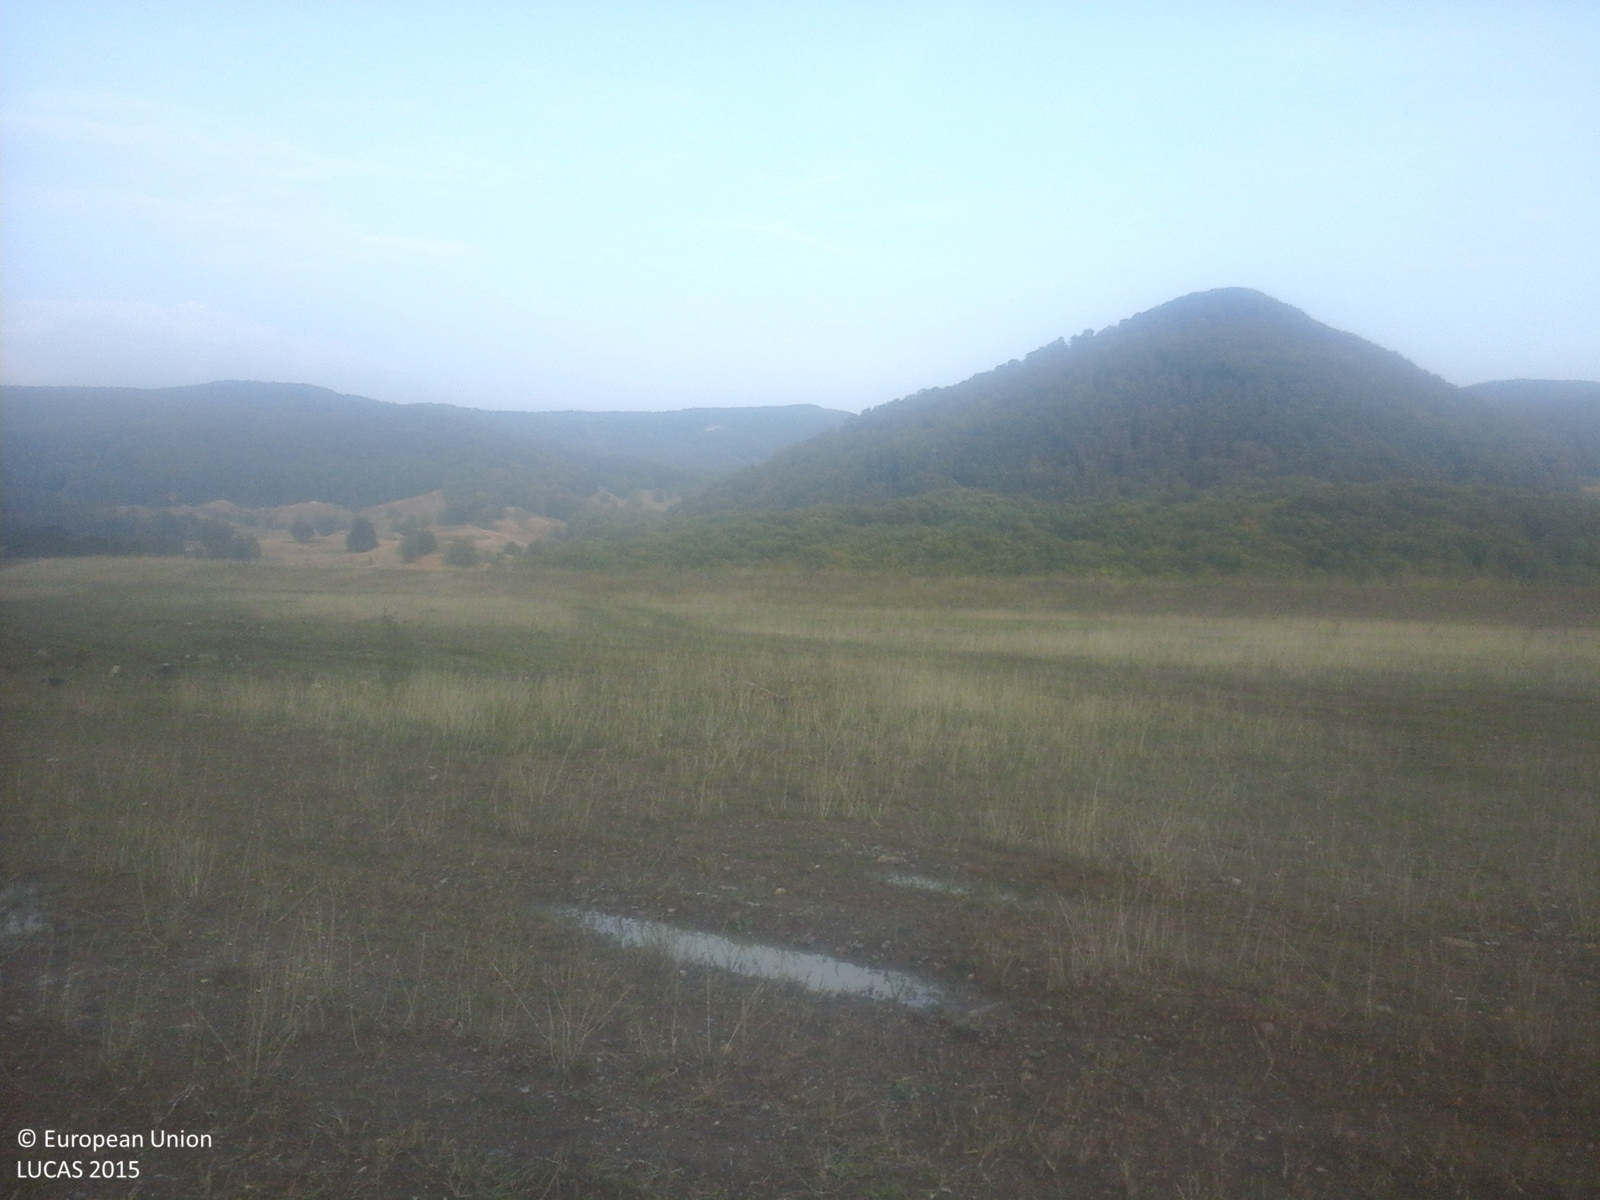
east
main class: Grassland
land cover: Grassland without tree/shrub cover
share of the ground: 50 - 75 %
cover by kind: herbaceous plants 100 %
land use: Agriculture (excluding fallow land and kitchen gardens)
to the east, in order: Grassland without tree/shrub cover; Tracks; Broadleaved woodland; Tracks; Broadleaved woodland
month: September
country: RO
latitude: 47.6243
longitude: 23.7992
